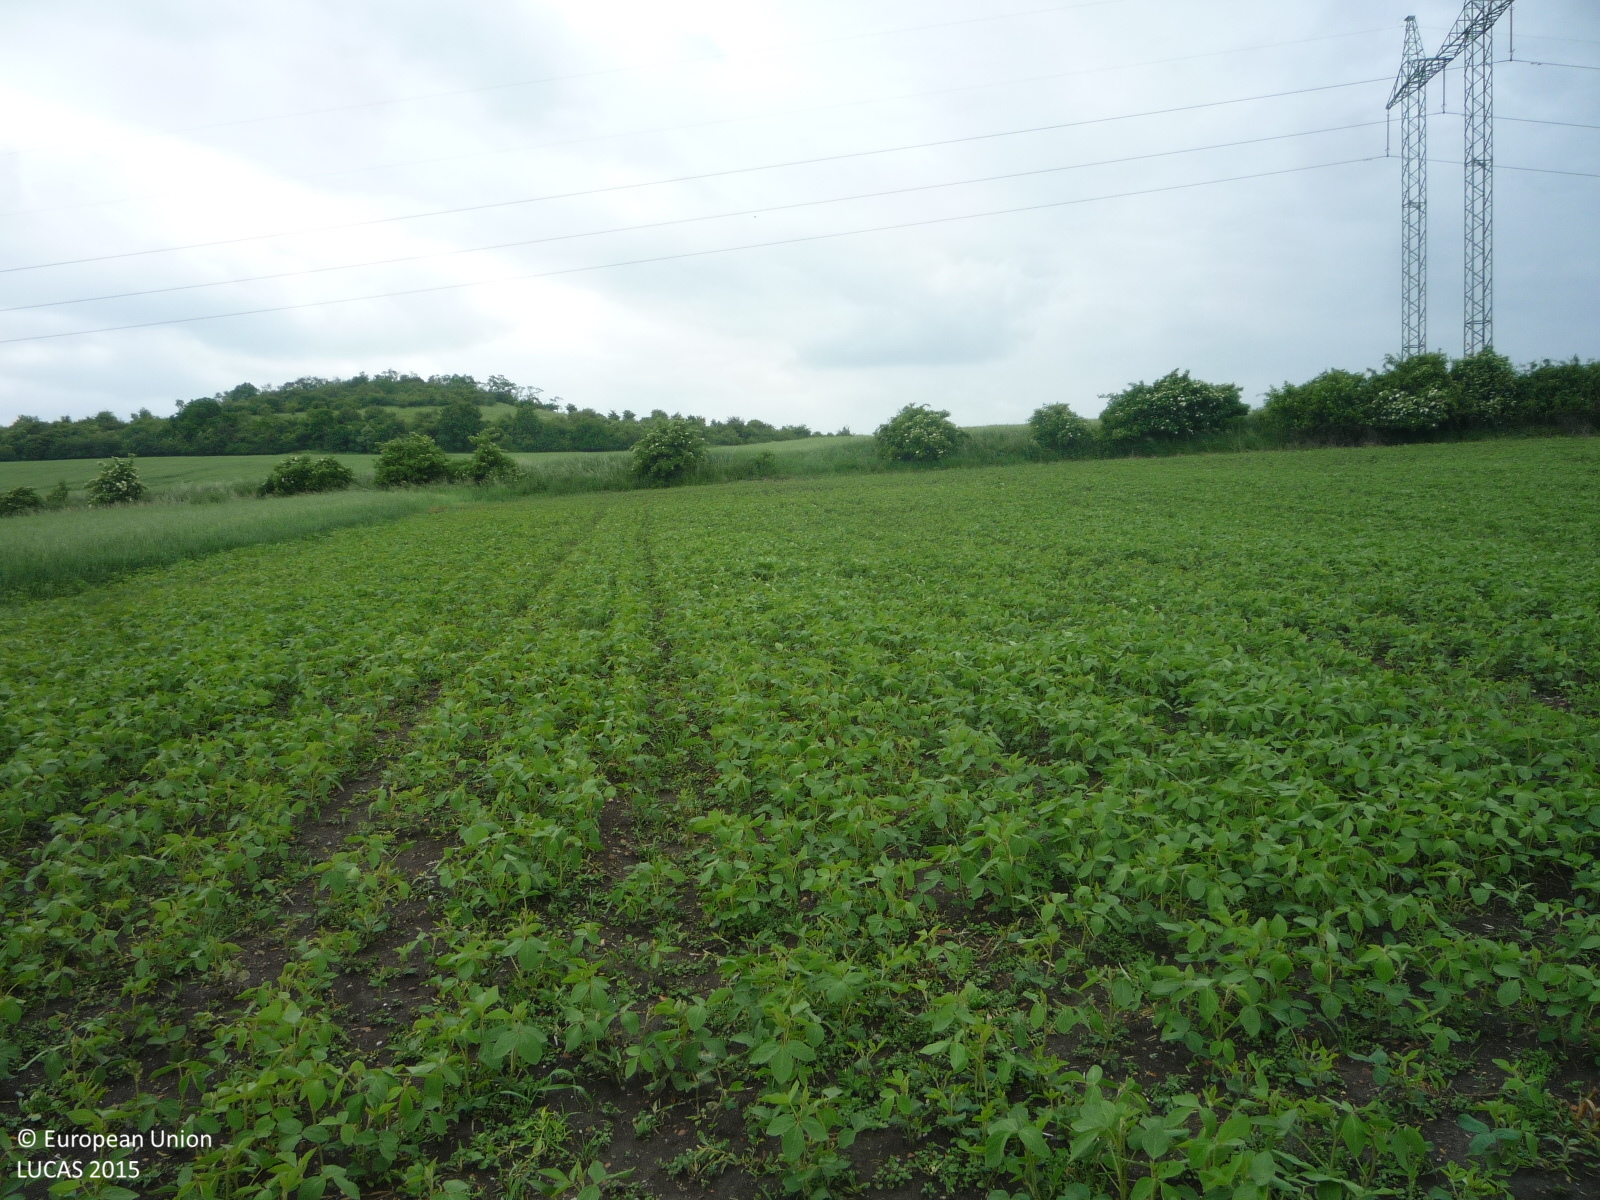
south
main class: Cropland
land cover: Soya
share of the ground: > 75 %
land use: Agriculture (excluding fallow land and kitchen gardens)
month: June
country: CZ
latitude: 50.3896
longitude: 13.8406
